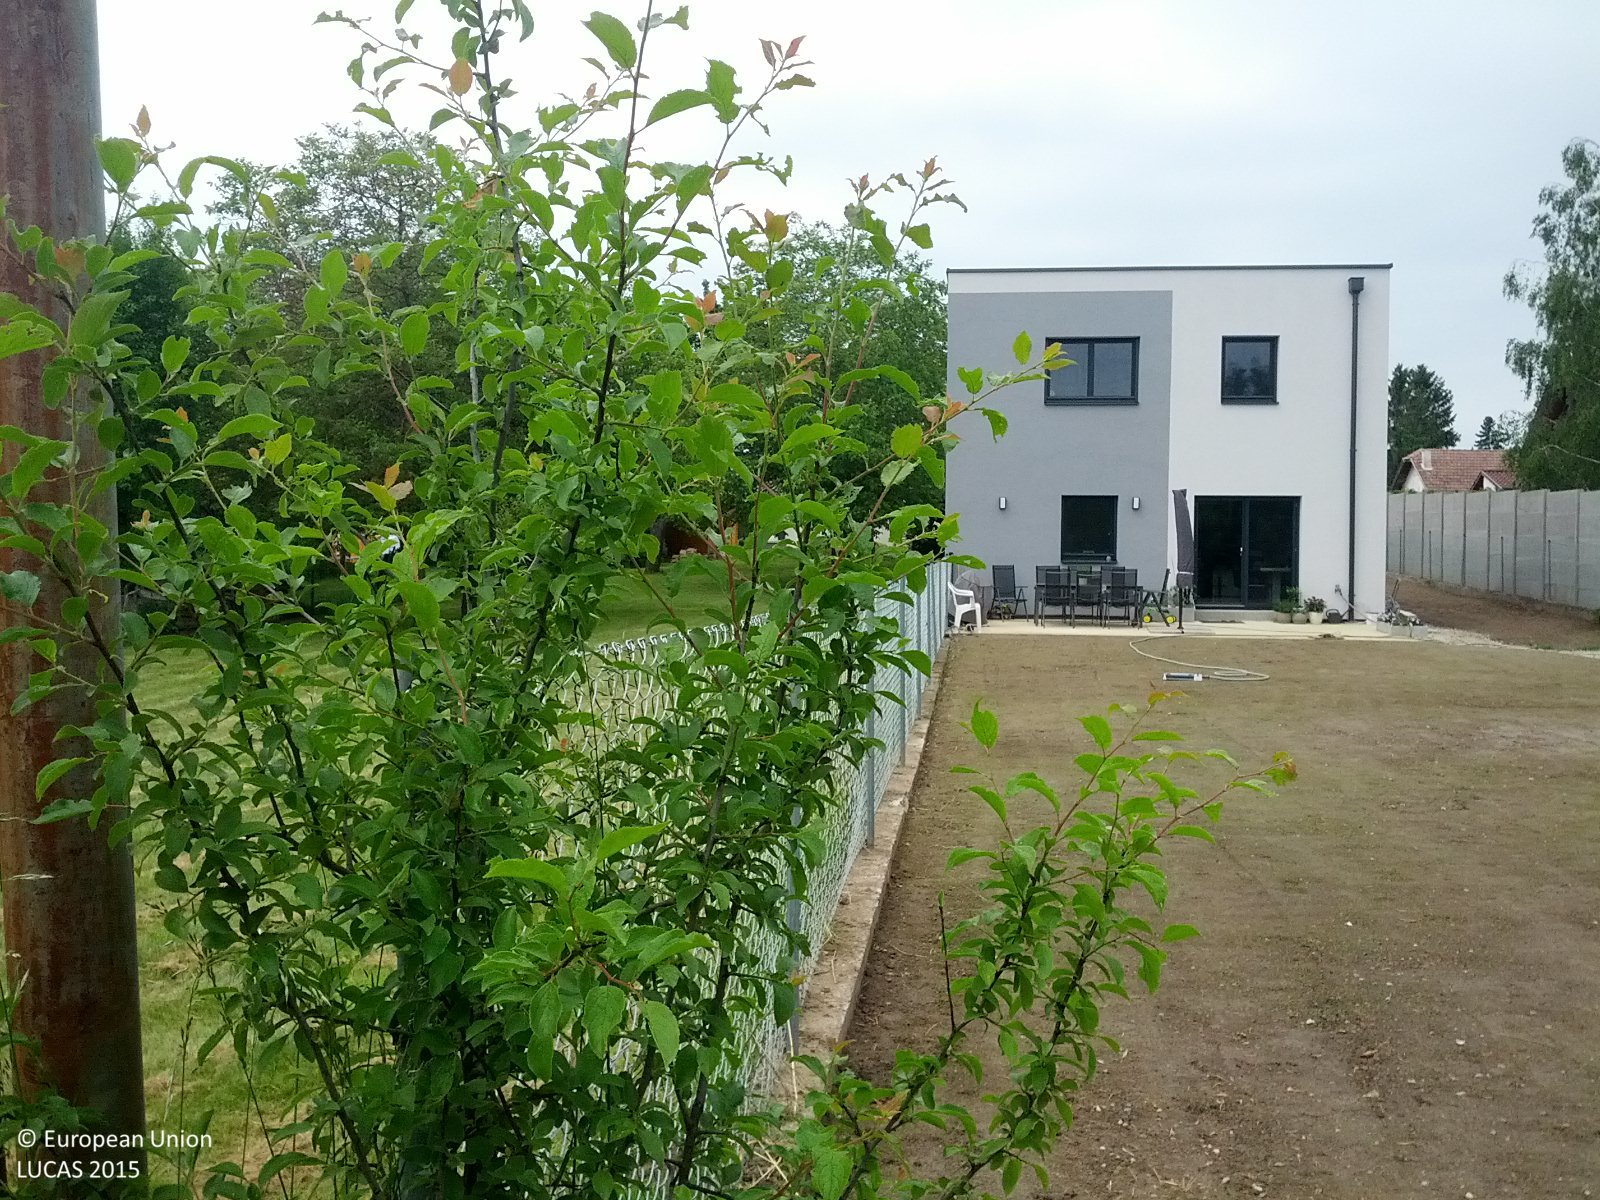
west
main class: Woodland
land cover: Broadleaved woodland
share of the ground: 25 - 50 %
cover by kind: herbaceous plants 50 %, broadleaved forest trees 45 %, shrubs 5 %
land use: Residential
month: May
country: AT
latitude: 48.1111
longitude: 16.6814
